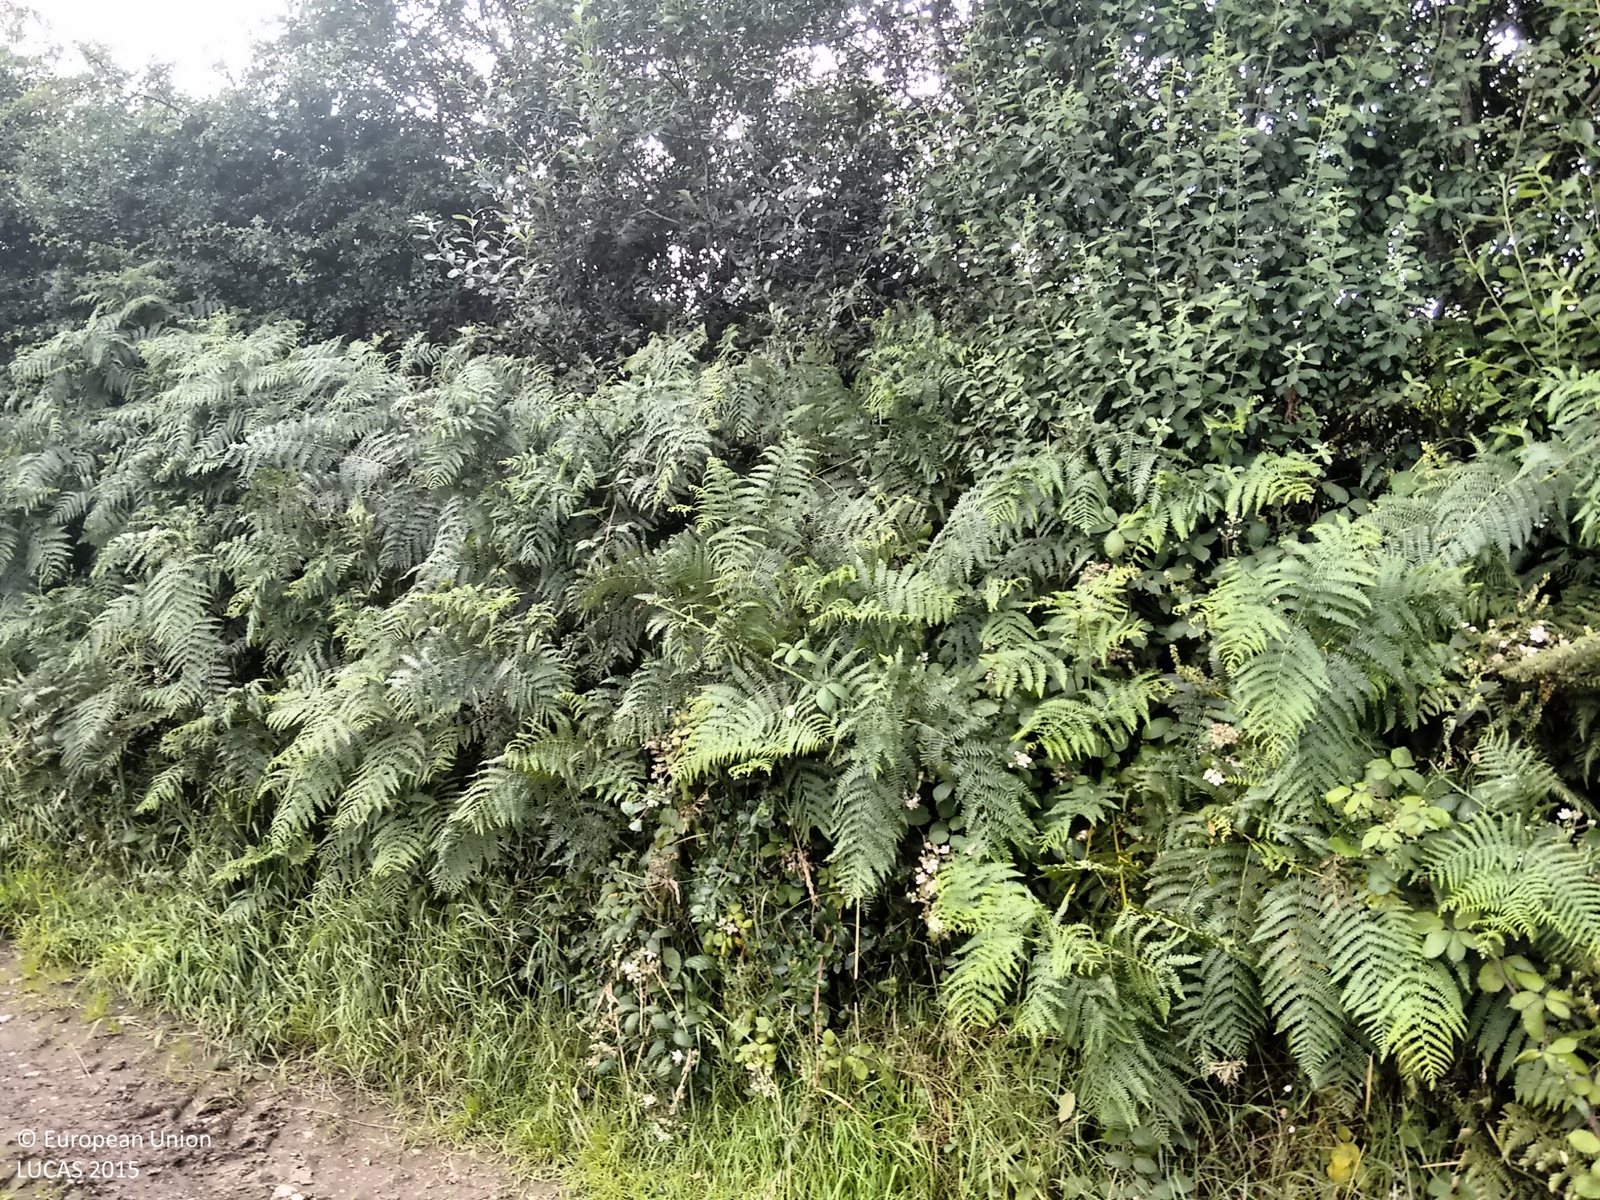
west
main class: Grassland
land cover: Grassland without tree/shrub cover
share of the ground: > 75 %
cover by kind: herbaceous plants 95 %, shrubs 5 %
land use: Agriculture (excluding fallow land and kitchen gardens)
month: August
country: IE
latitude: 52.1223
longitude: -9.7418
